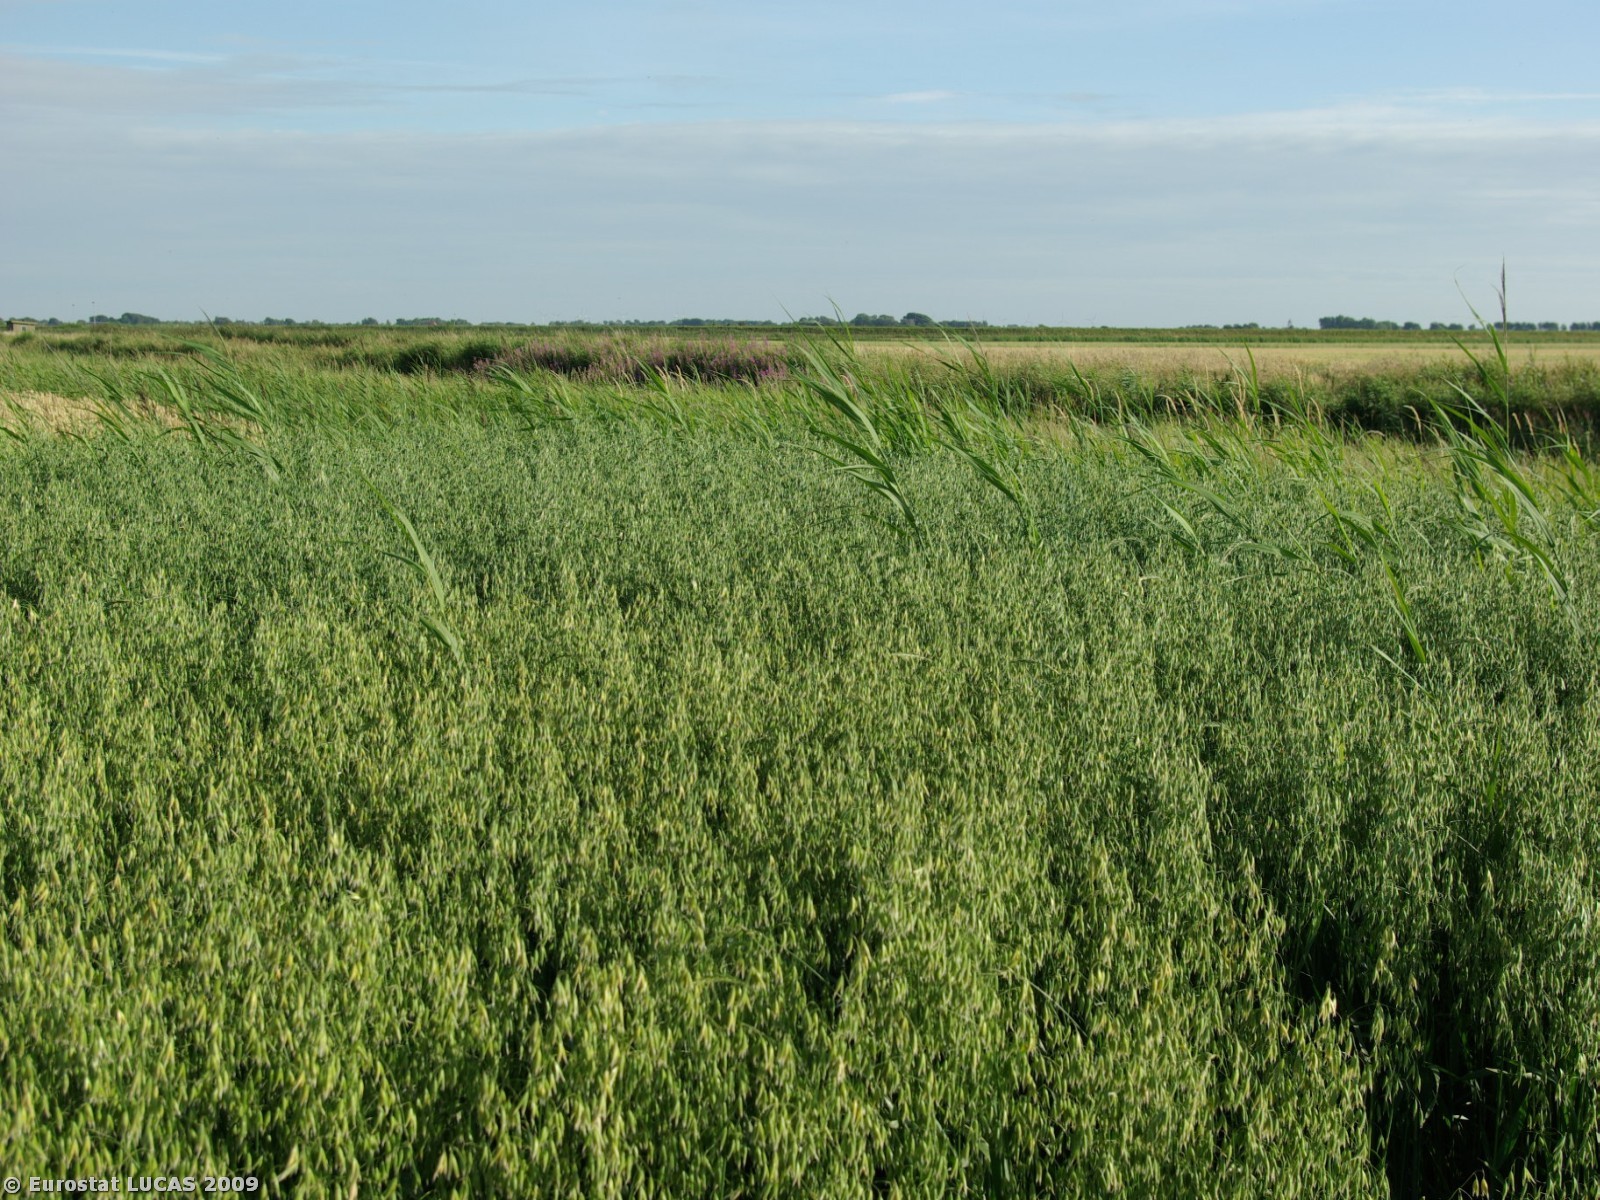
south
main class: Cropland
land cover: Oats
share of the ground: > 75 %
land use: Agriculture (excluding fallow land and kitchen gardens)
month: July
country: DK
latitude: 54.9052
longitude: 8.7376
